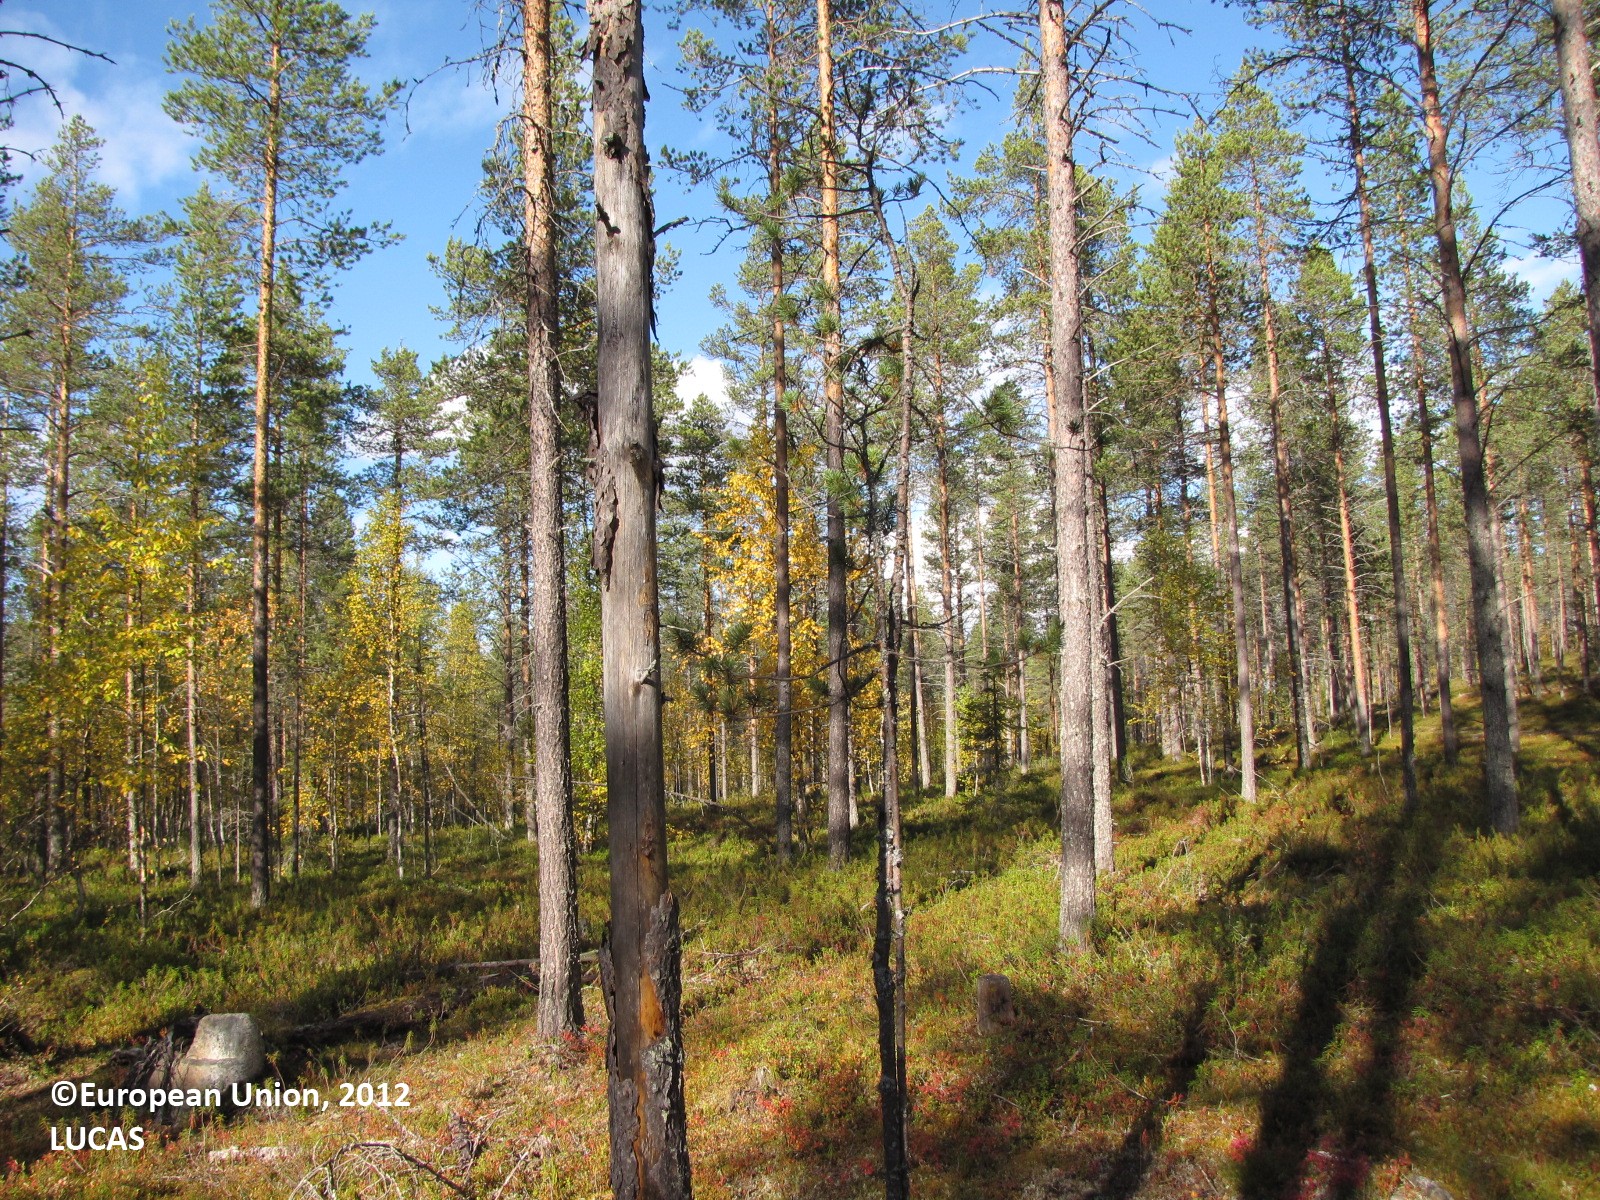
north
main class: Woodland
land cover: Pine dominated coniferous woodland
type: boreal forest
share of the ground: 25 - 50 %
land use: Forestry
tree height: > 5 m
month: September
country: FI
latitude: 67.2963
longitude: 24.8761
